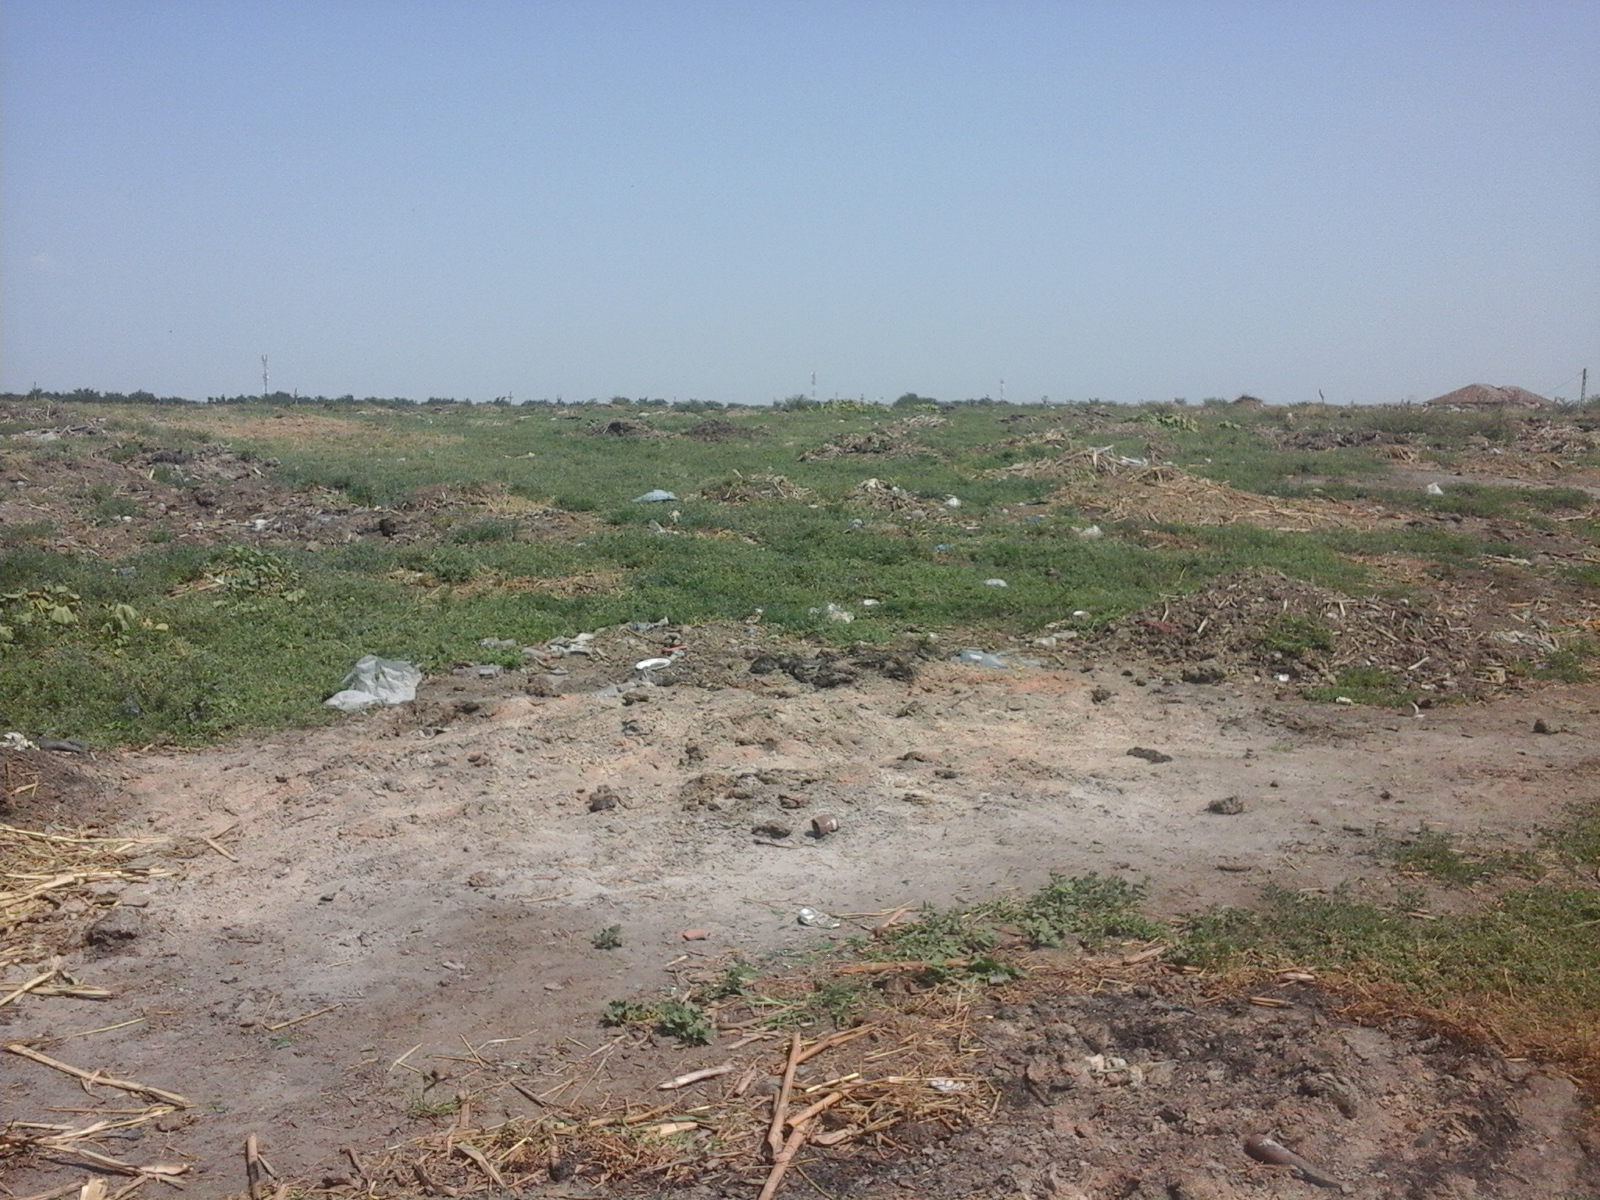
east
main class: Grassland
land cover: Spontaneously vegetated surfaces
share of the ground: 50 - 75 %
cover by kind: herbaceous plants 70 %, consolidated bare surface 30 %
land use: Fallow land
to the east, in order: Spontaneously vegetated surfaces; Tracks; Maize; Tracks; Common wheat
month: August
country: RO
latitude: 45.0376
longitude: 27.7373
